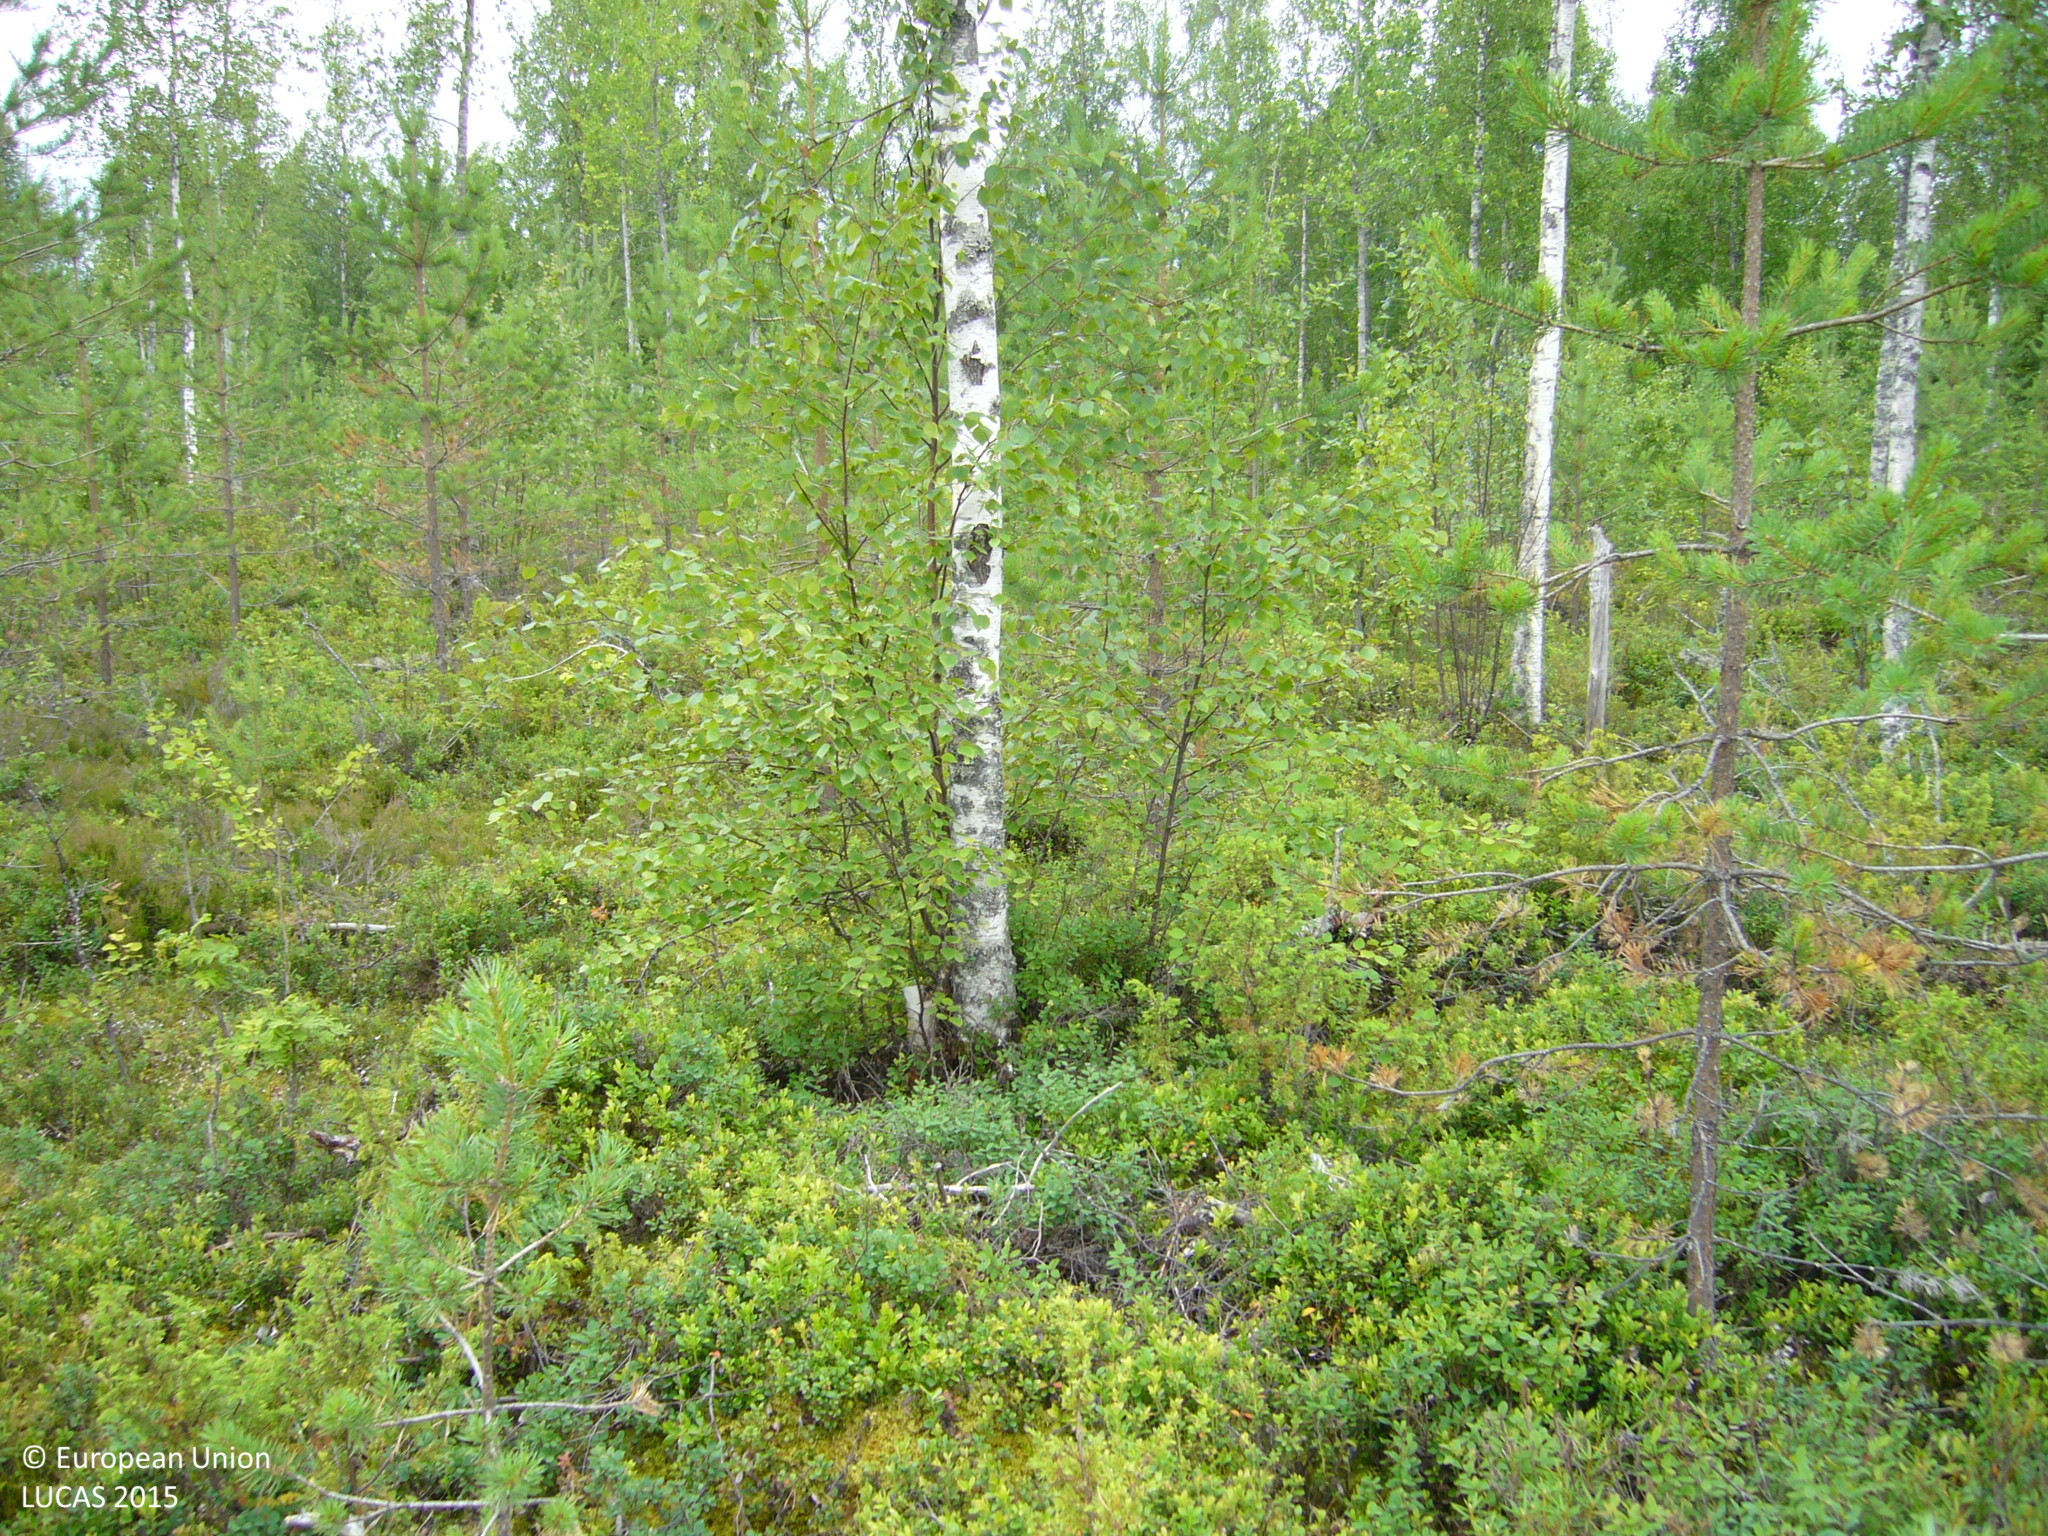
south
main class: Woodland
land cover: Pine dominated mixed woodland
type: boreal forest
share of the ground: 50 - 75 %
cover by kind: coniferous forest trees 40 %, broadleaved forest trees 30 %, shrubs 30 %
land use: Forestry
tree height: < 5 m
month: July
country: FI
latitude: 63.9755
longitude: 26.2736
